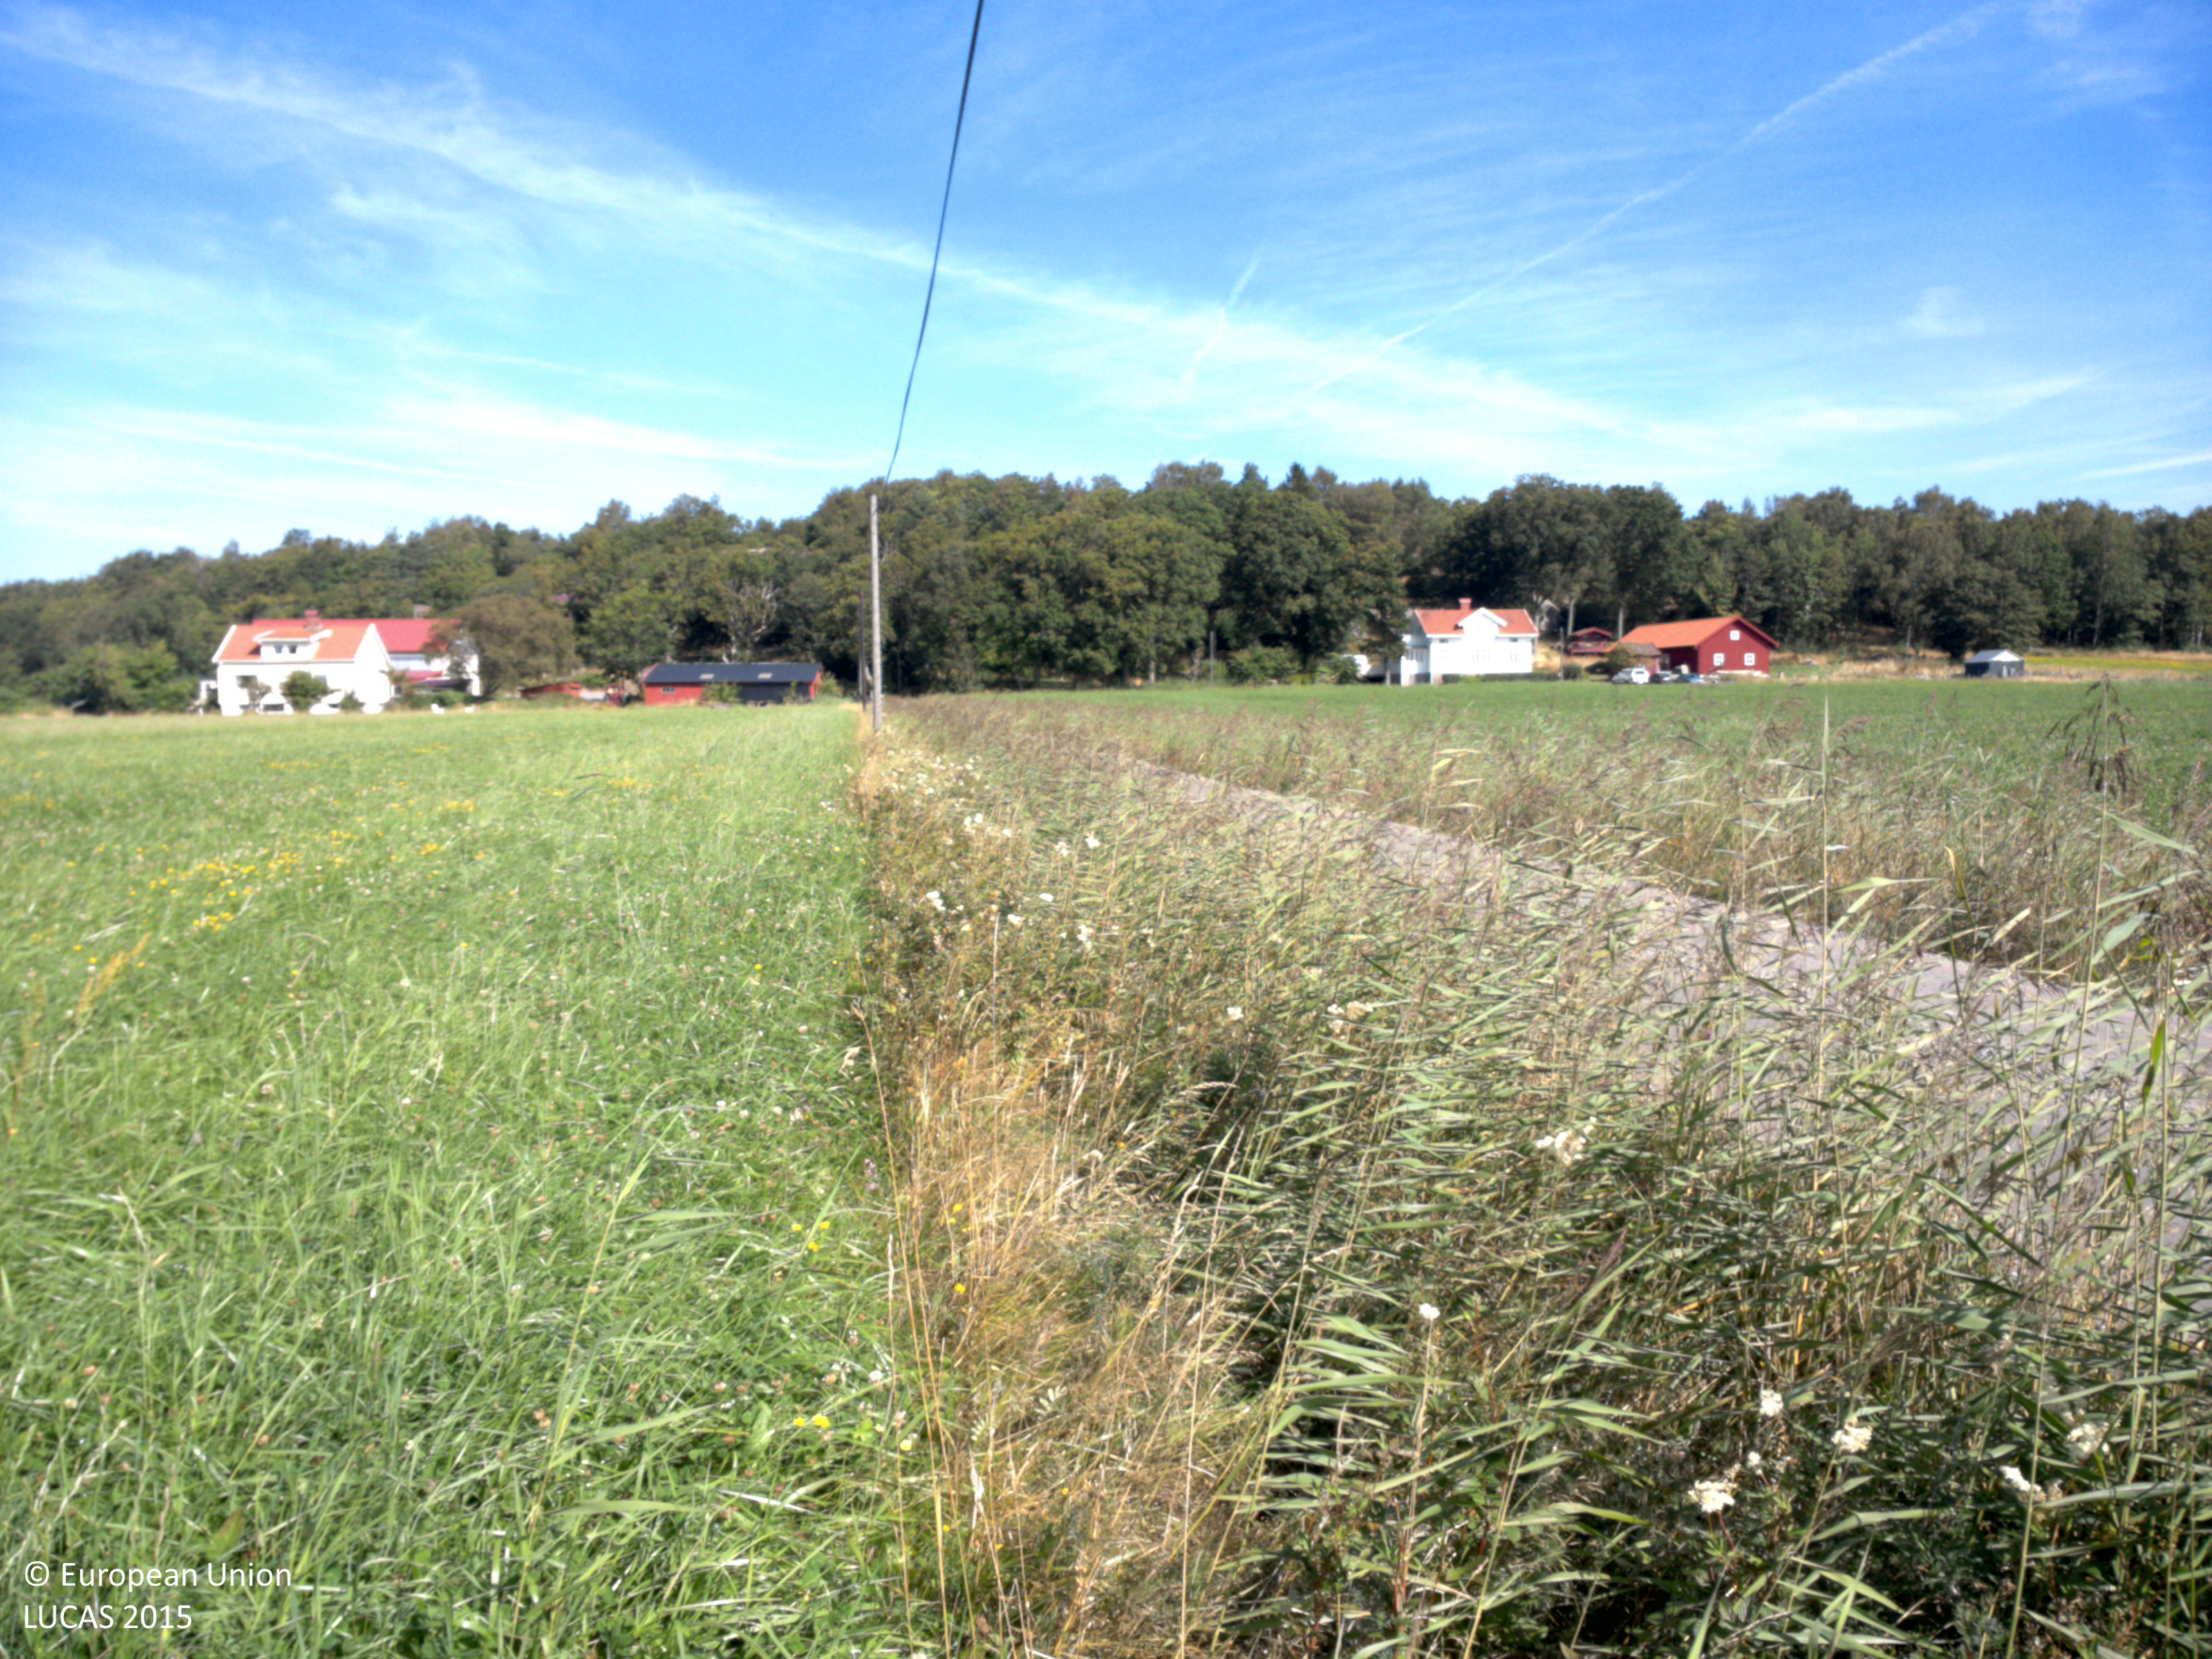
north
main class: Cropland
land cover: Temporary grasslands
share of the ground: > 75 %
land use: Agriculture (excluding fallow land and kitchen gardens)
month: August
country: SE
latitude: 57.8292
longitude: 11.8322
